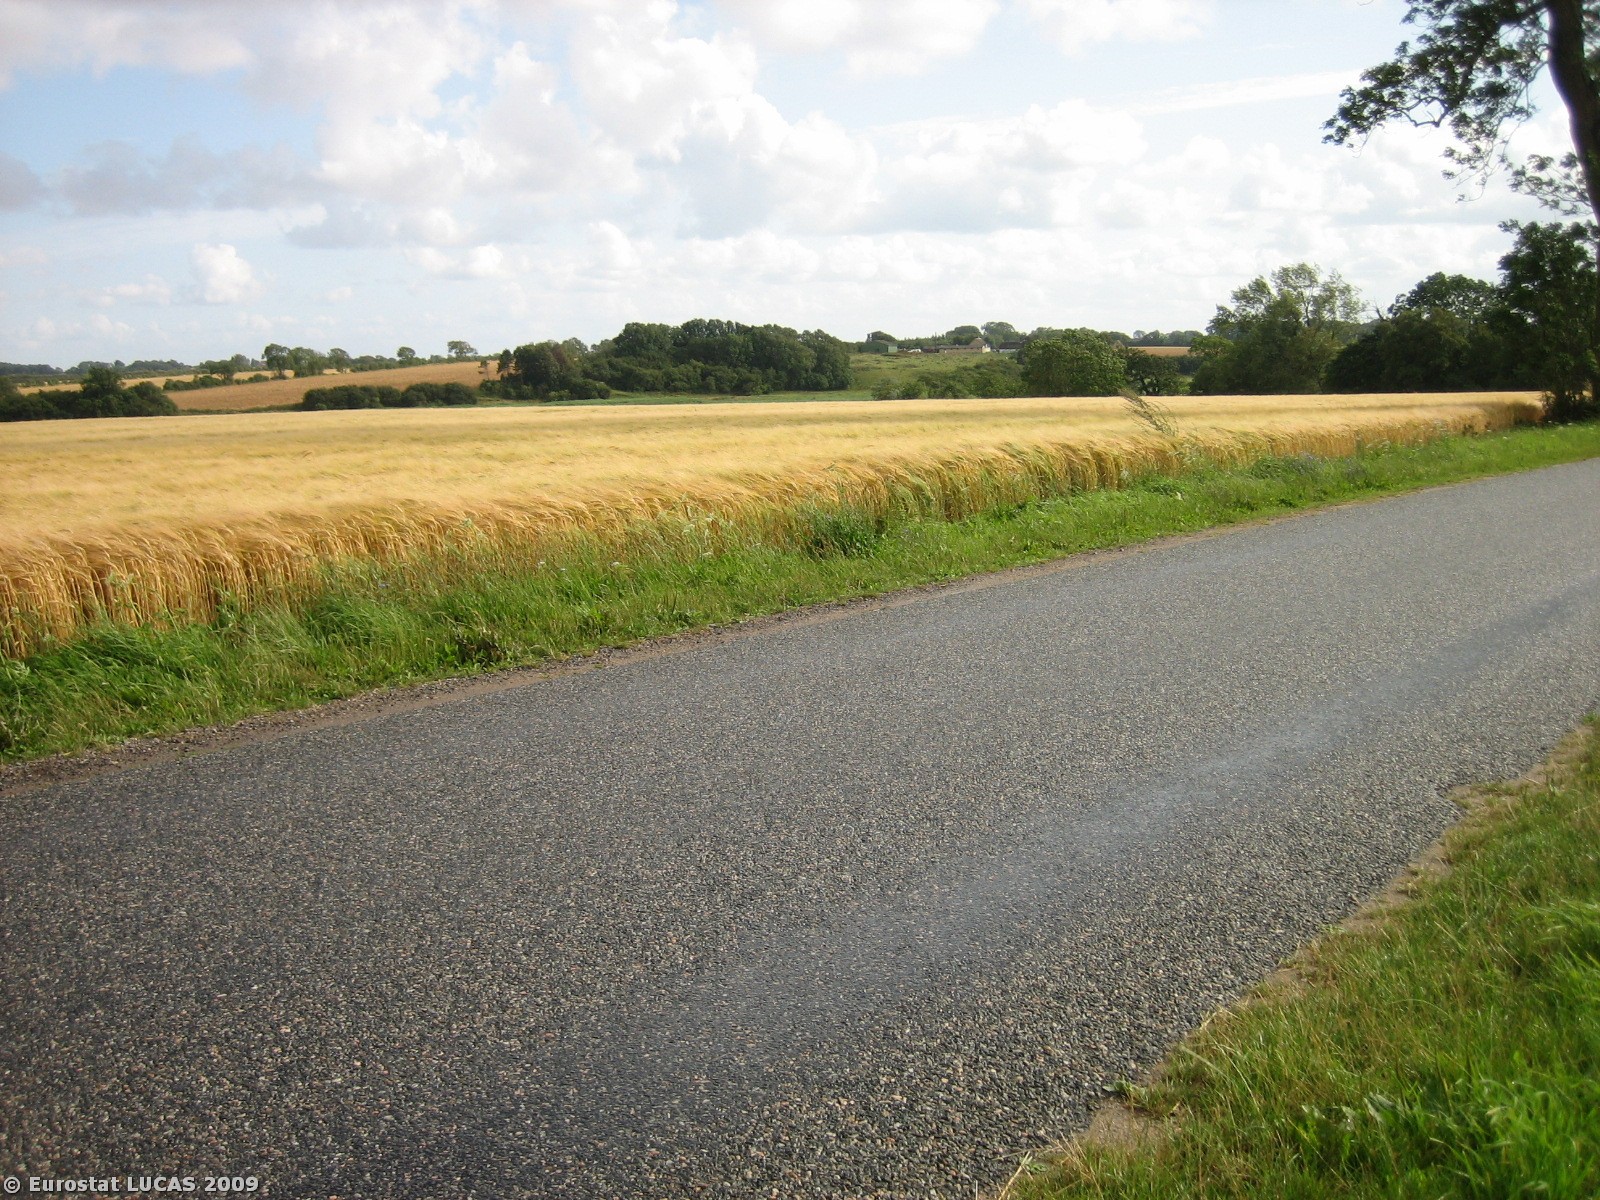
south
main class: Cropland
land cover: Barley
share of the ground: > 75 %
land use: Agriculture (excluding fallow land and kitchen gardens)
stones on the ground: < 10 %
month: July
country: DK
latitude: 55.3968
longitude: 9.8580
